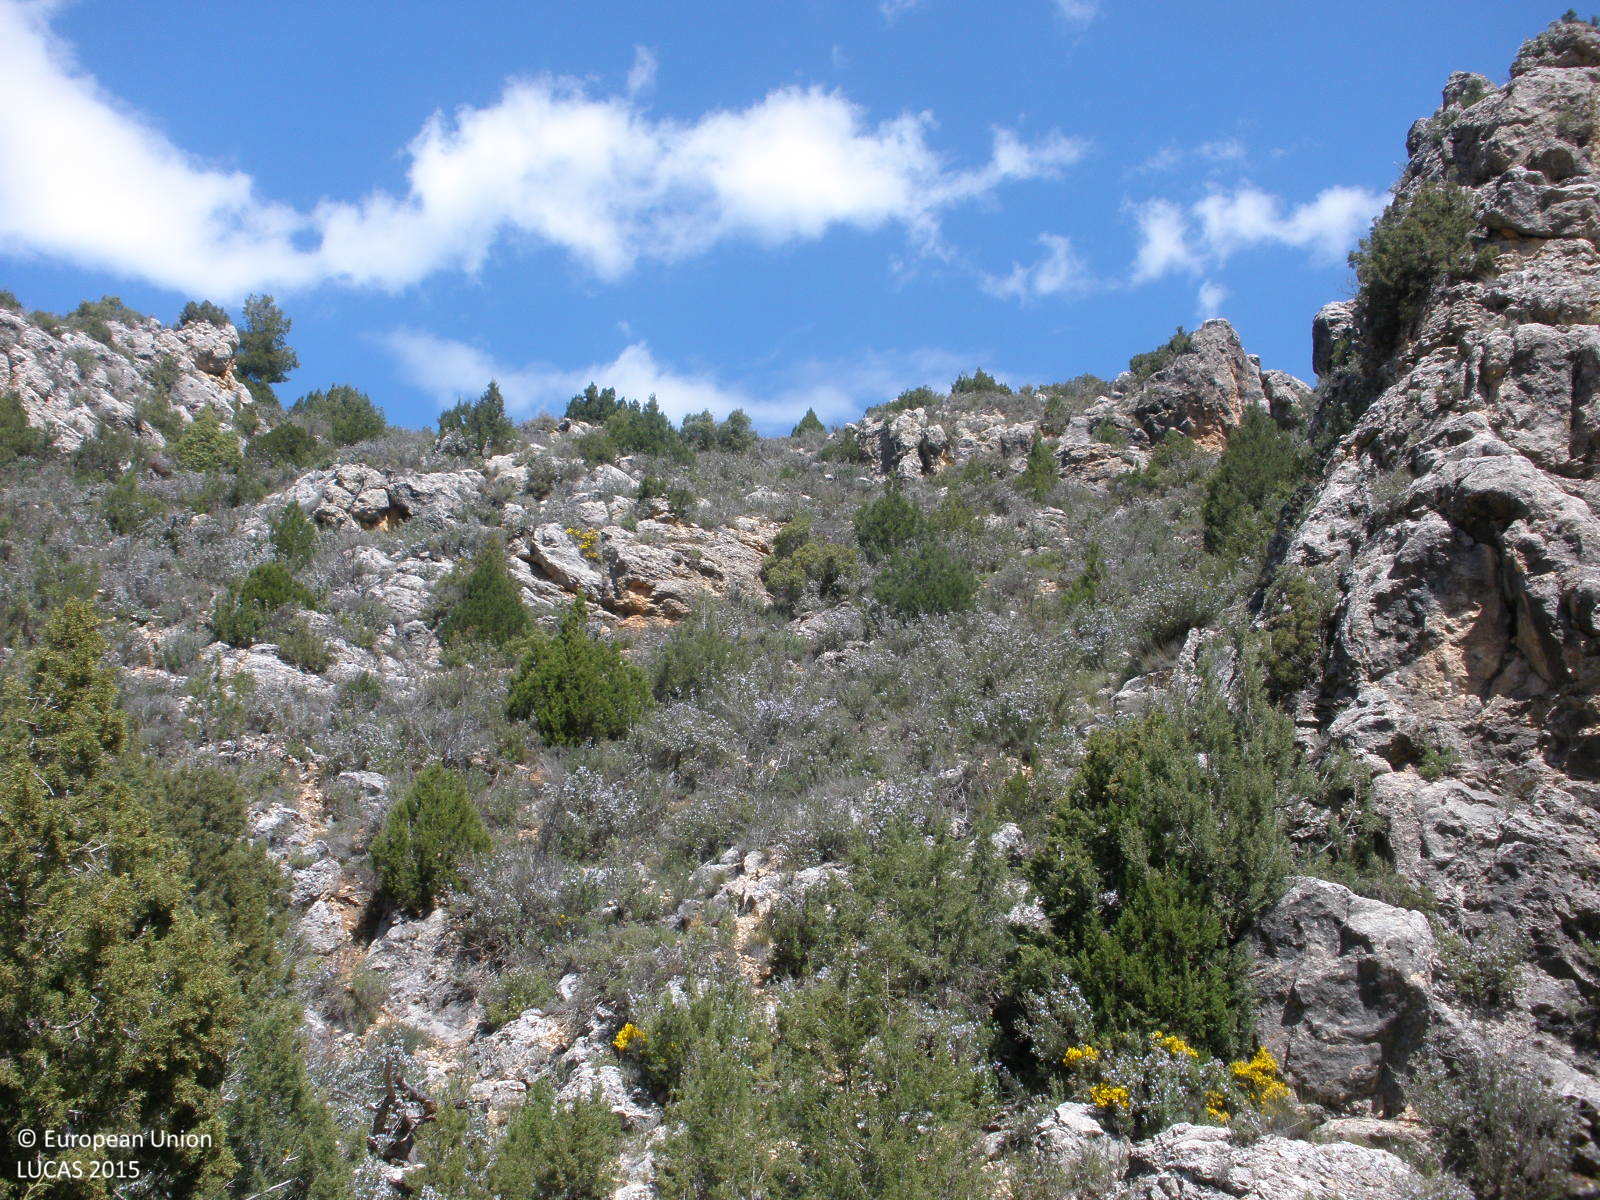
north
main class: Woodland
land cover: Pine dominated coniferous woodland
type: coniferous forest of the mediterranean region
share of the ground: 25 - 50 %
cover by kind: shrubs 45 %, consolidated bare surface 30 %, coniferous forest trees 25 %
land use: Semi-natural and natural areas not in use
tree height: > 5 m
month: April
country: ES
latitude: 40.2223
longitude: -1.2329
